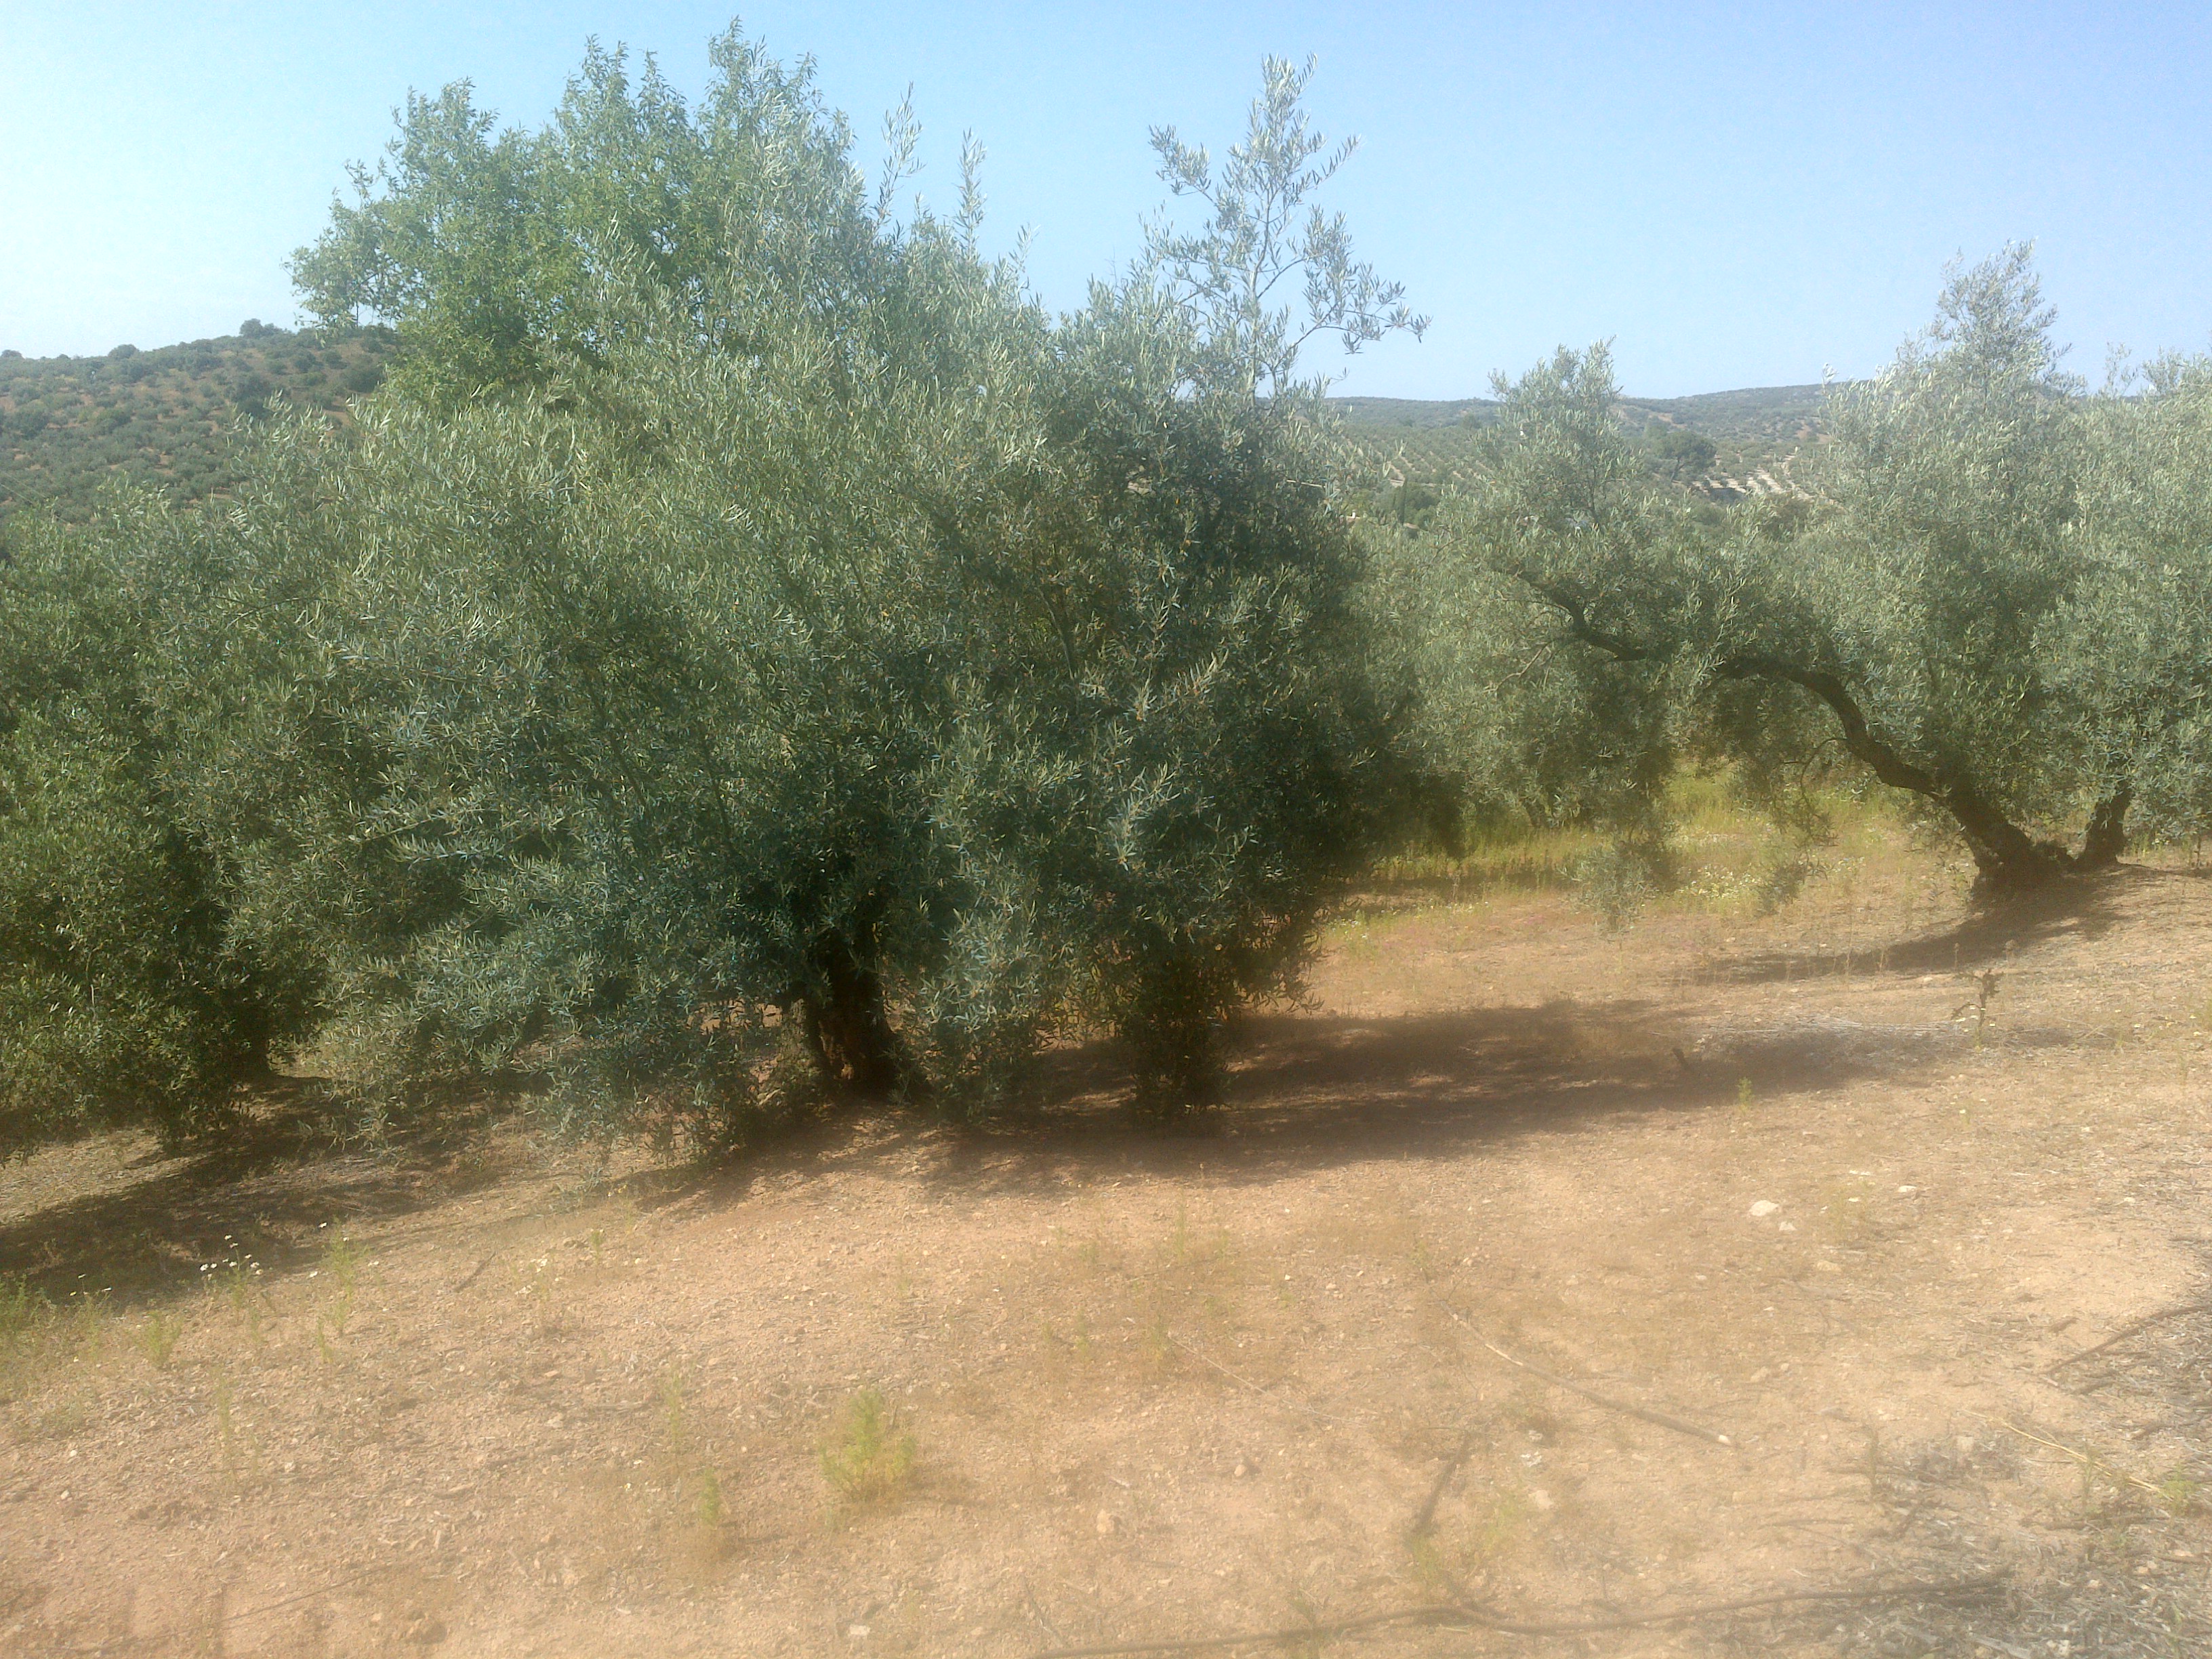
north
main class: Cropland
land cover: Olive groves
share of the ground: 25 - 50 %
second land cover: Spontaneously vegetated surfaces
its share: 10 - 25 %
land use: Agriculture (excluding fallow land and kitchen gardens)
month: May
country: ES
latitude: 37.4519
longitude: -4.4154
